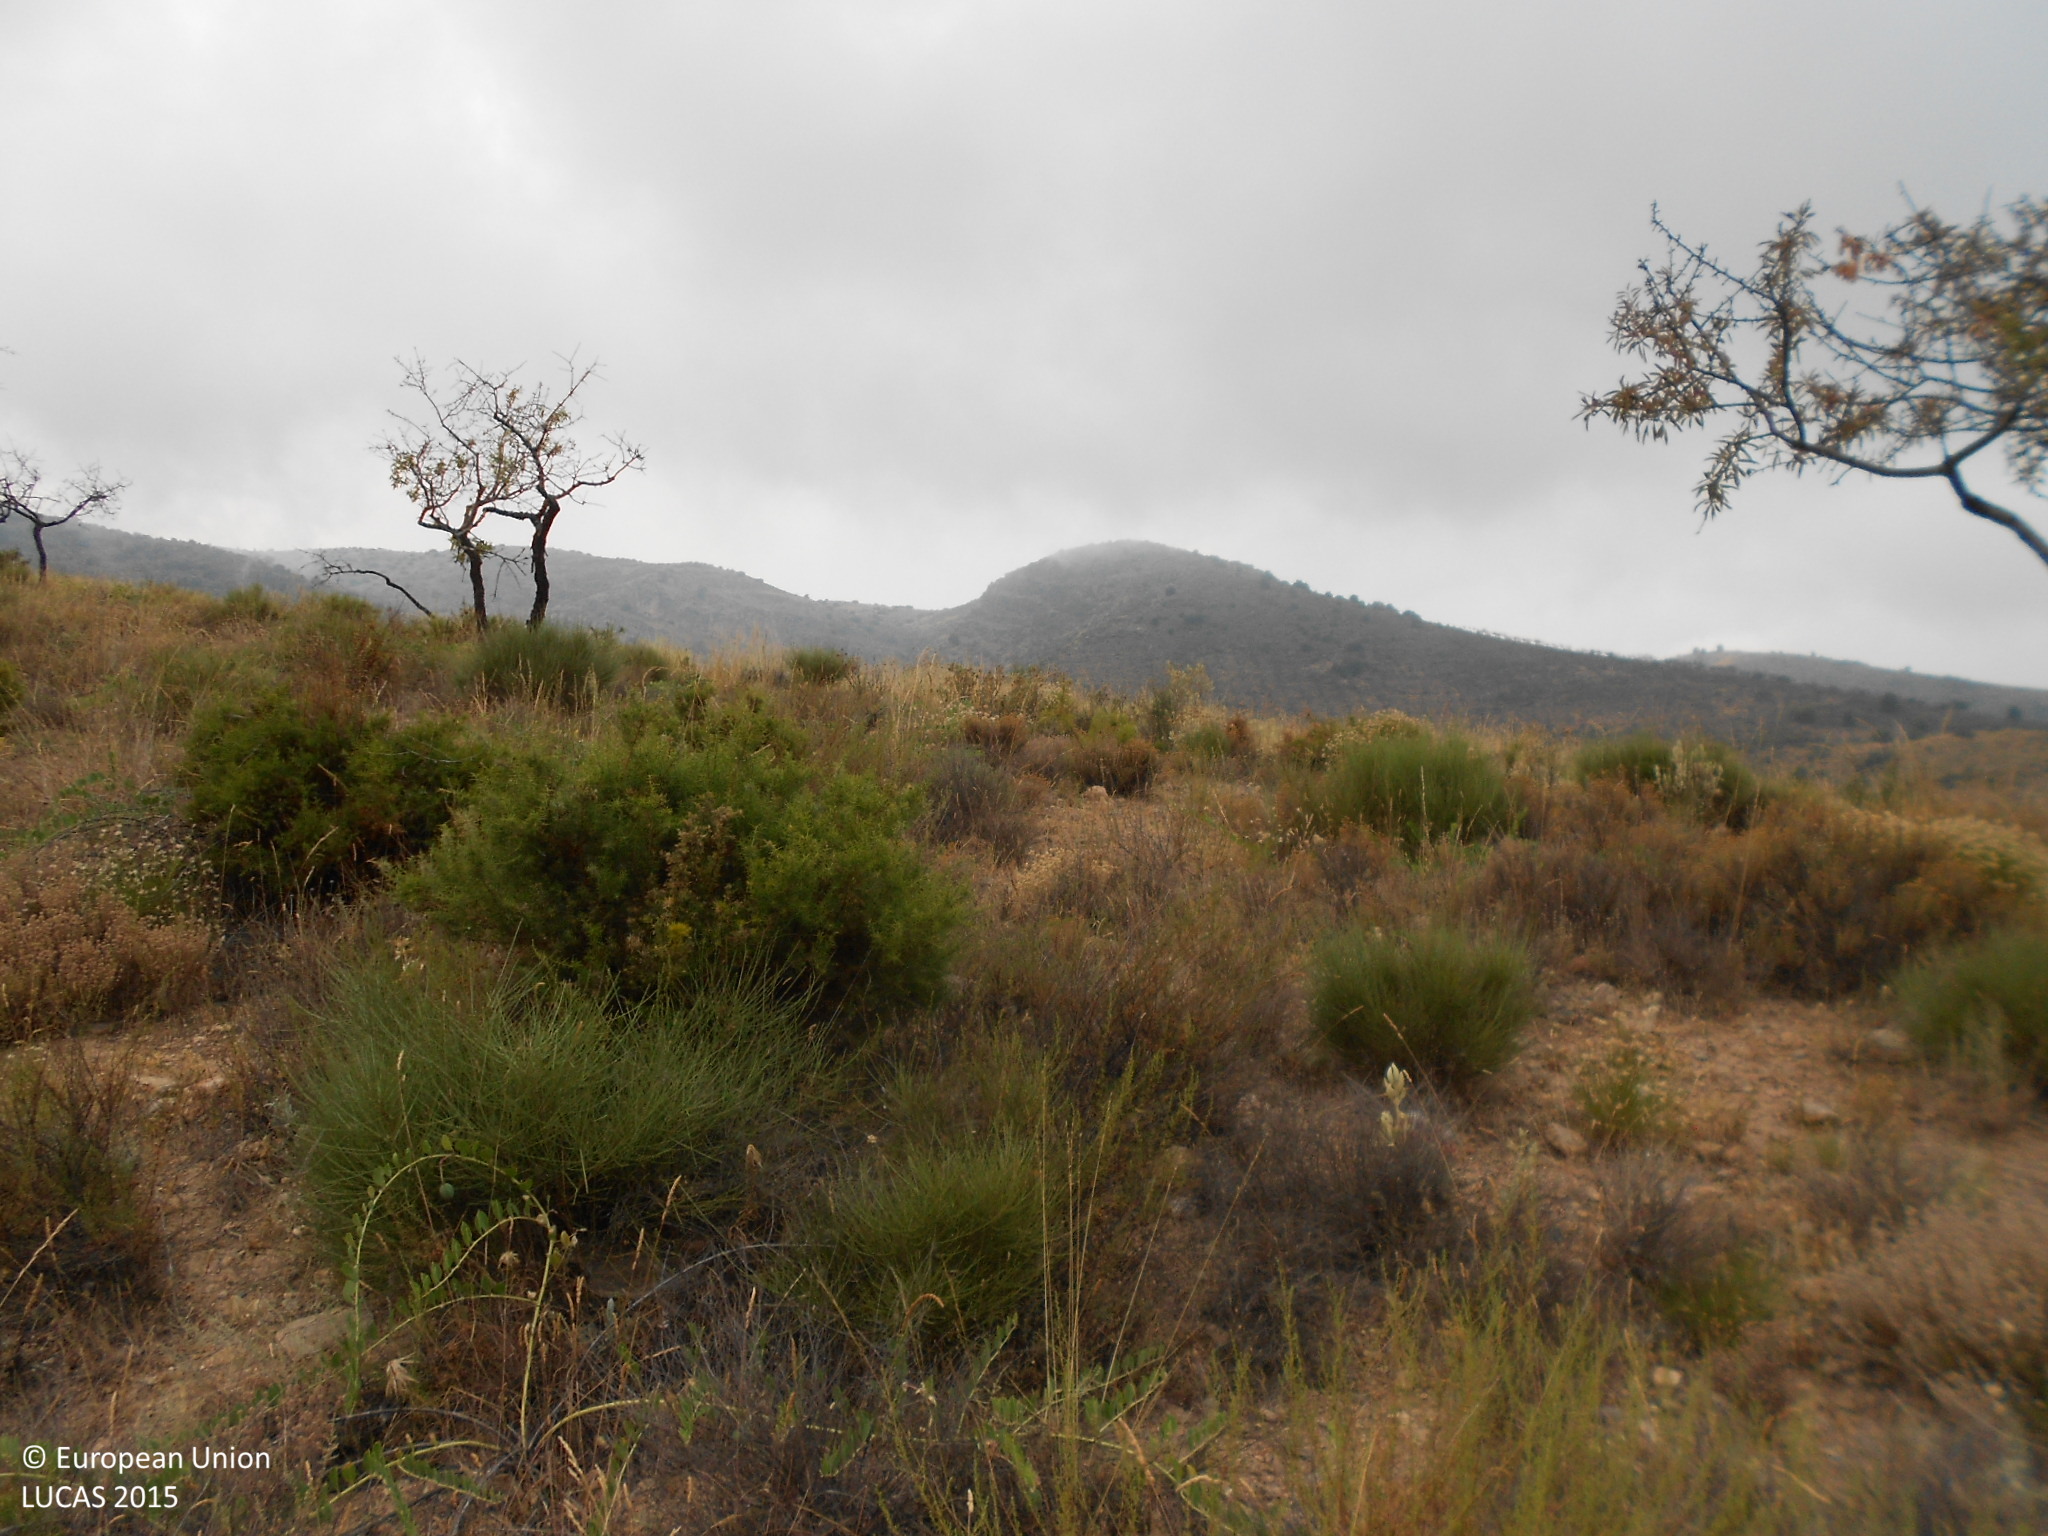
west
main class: Cropland
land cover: Nuts trees
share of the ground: 10 - 25 %
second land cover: Shrubland without tree cover
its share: 25 - 50 %
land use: Abandoned areas
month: July
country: ES
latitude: 36.9709
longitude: -2.7959
